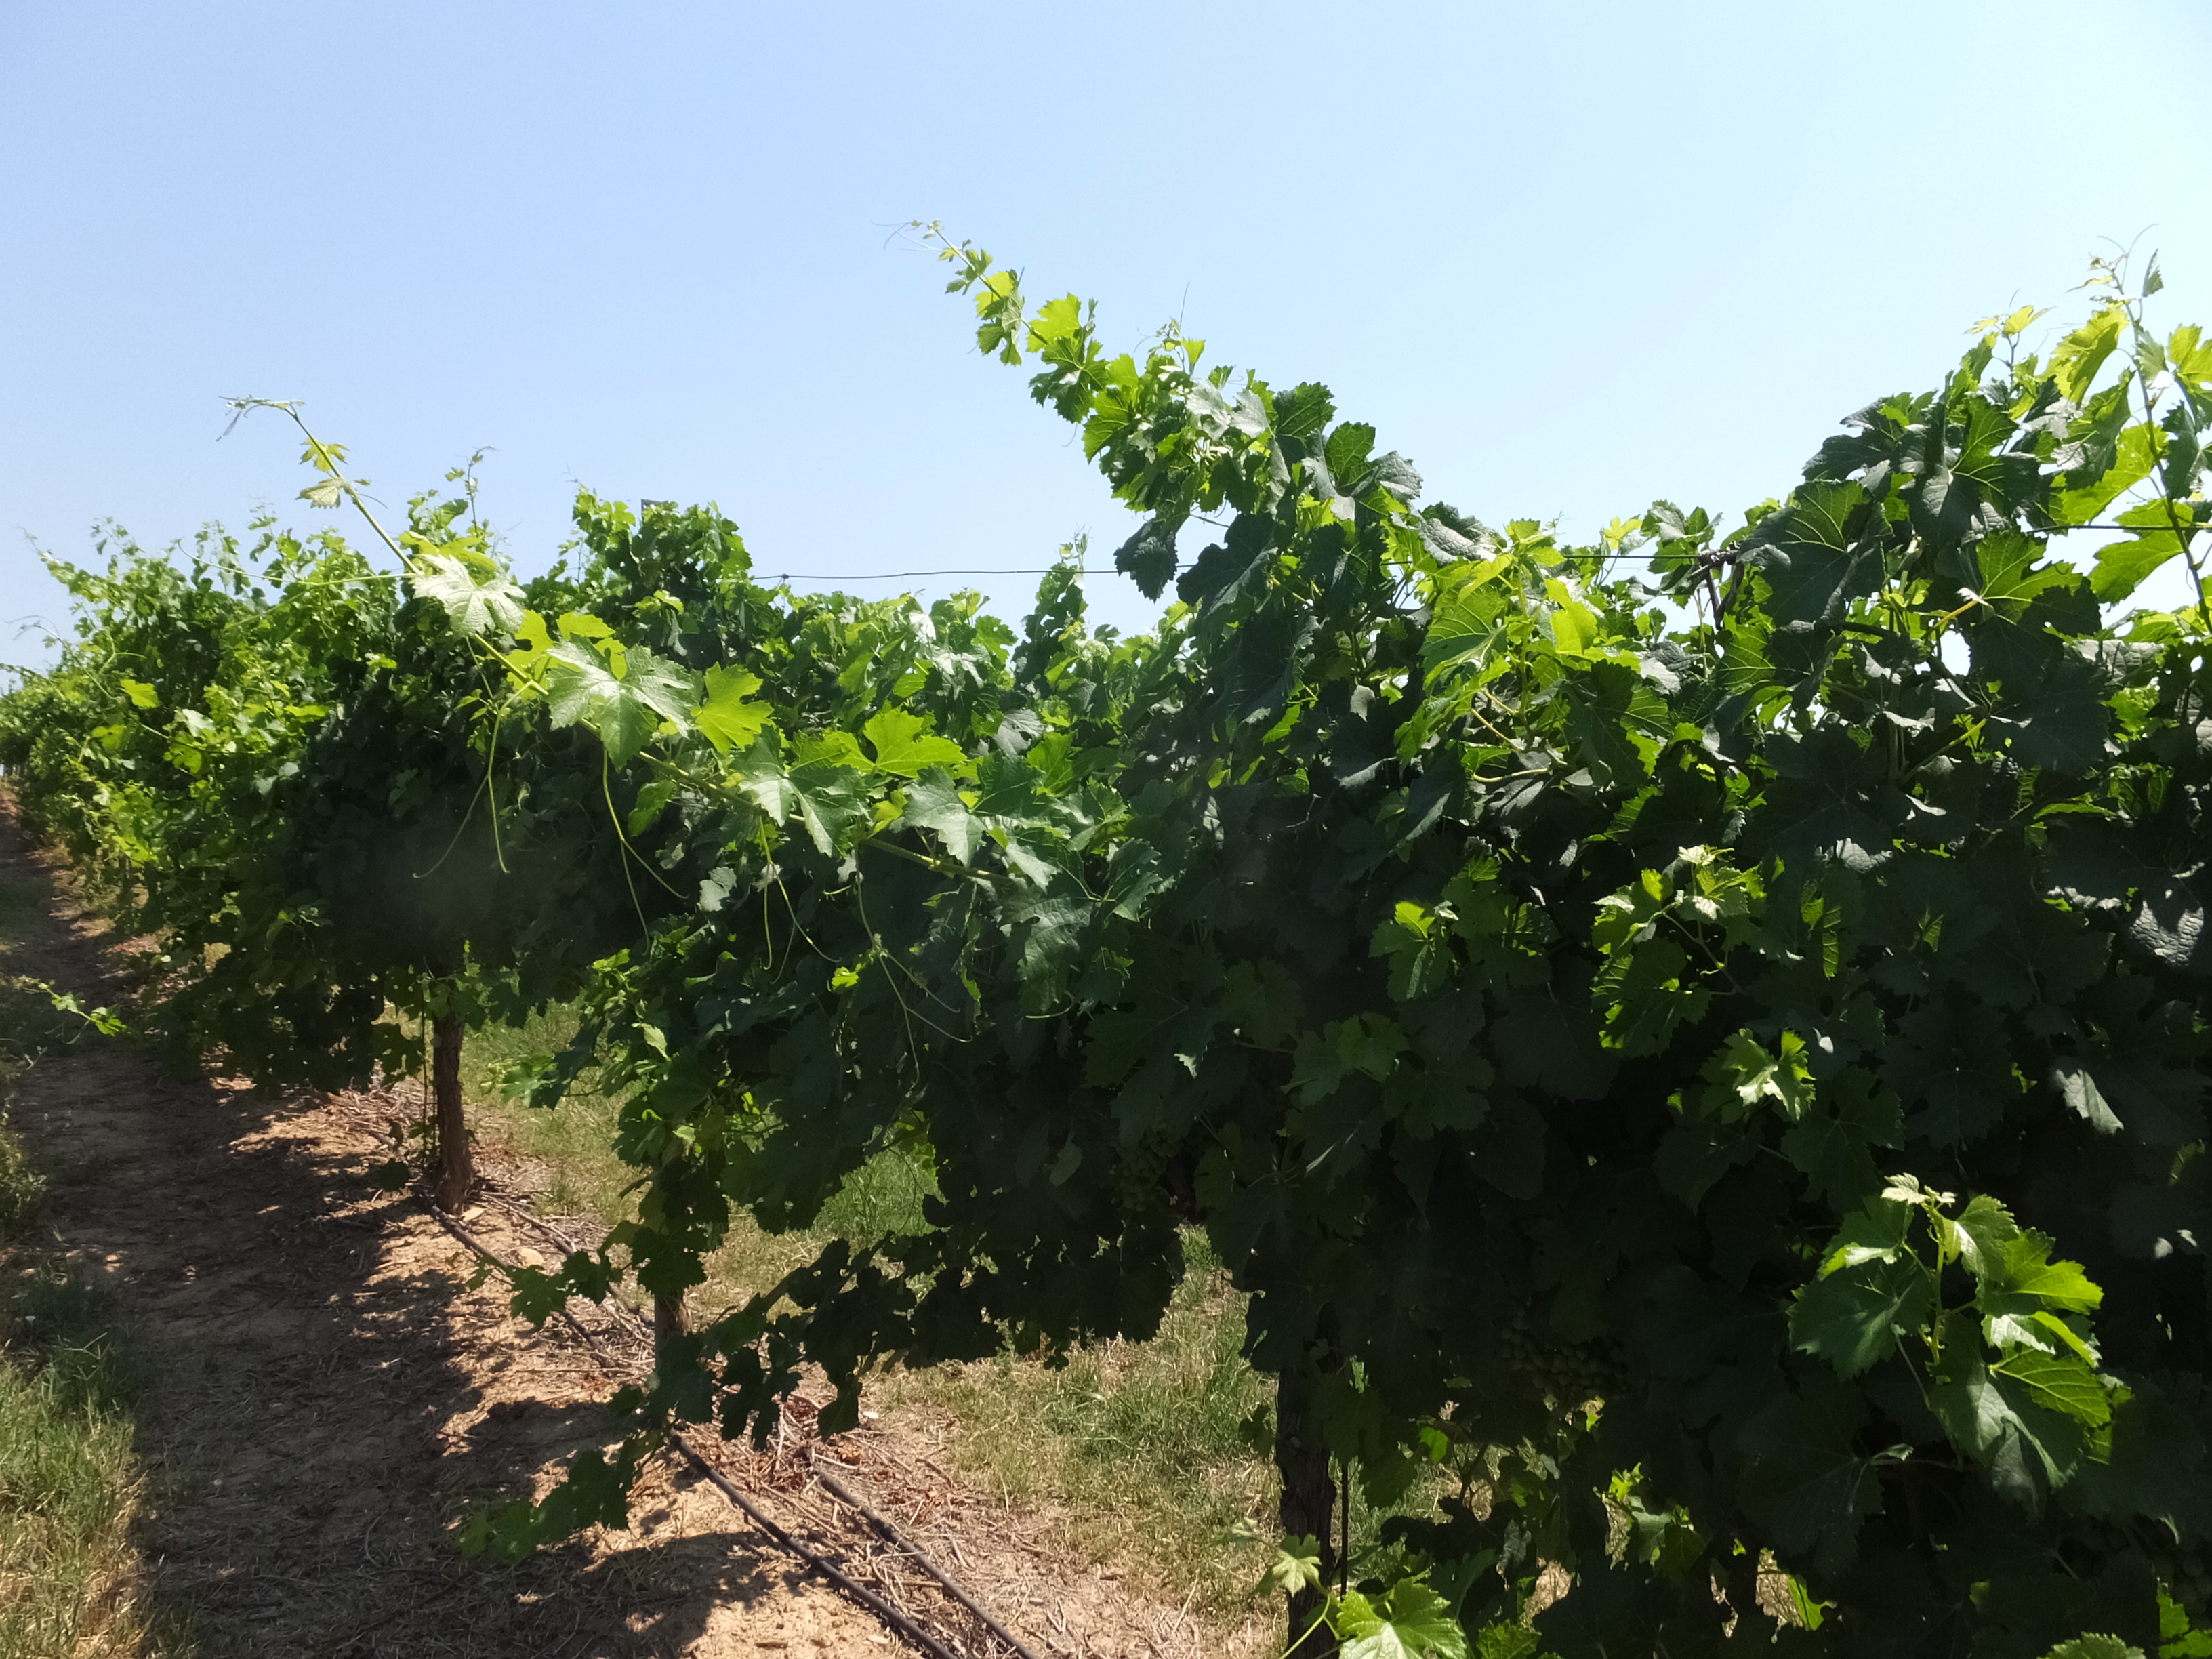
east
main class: Cropland
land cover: Vineyards
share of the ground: > 75 %
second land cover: Spontaneously vegetated surfaces
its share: 25 - 50 %
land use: Agriculture (excluding fallow land and kitchen gardens)
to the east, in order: Vineyards; Spontaneously vegetated surfaces; Artificial constructions in urban areas; Tracks; Maize; Single bushes/trees; Maize; Single bushes/trees; Artificial constructions in urban areas; Grass margins; Tracks; Grass margins; Electric lines; Maize
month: June
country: ES
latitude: 41.7451
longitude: 0.4259
